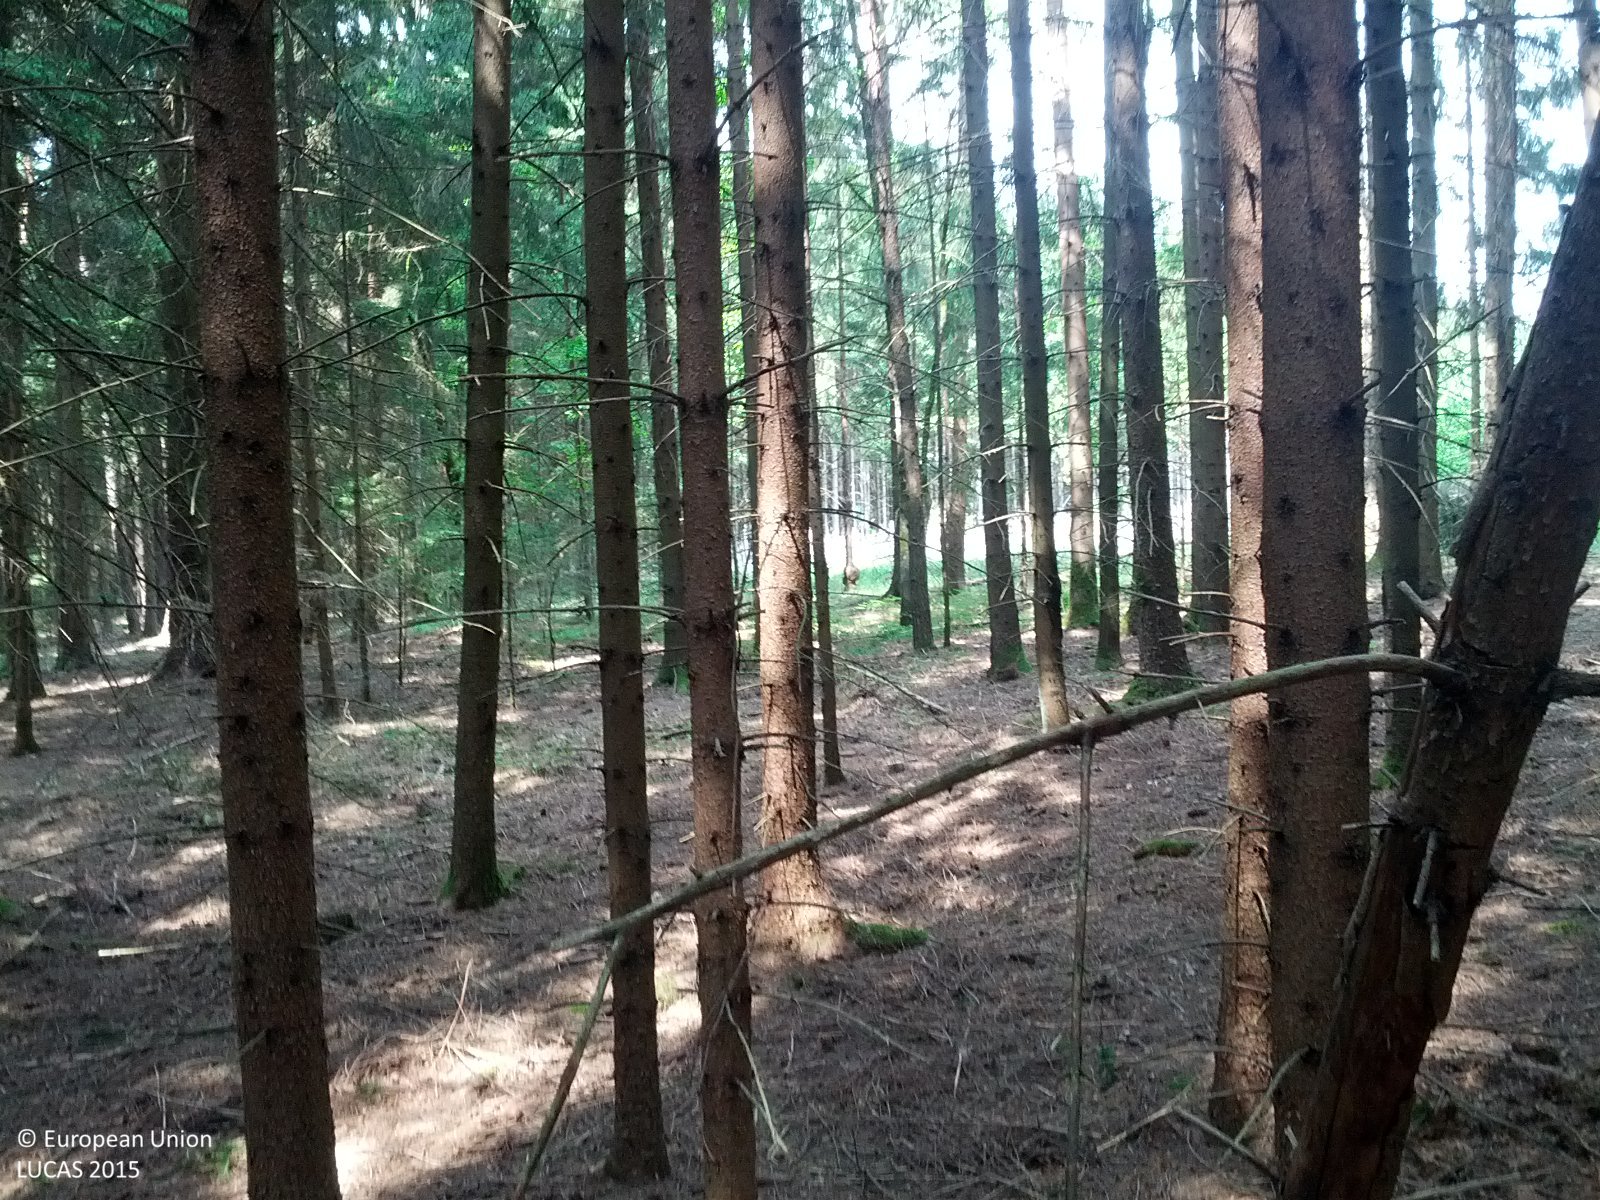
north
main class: Woodland
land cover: Spruce dominated coniferous woodland
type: boreal forest
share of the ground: > 75 %
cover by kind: coniferous forest trees 70 %, unconsolidated bare surface 30 %
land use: Forestry
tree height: > 5 m
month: May
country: AT
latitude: 47.3116
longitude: 16.1533
